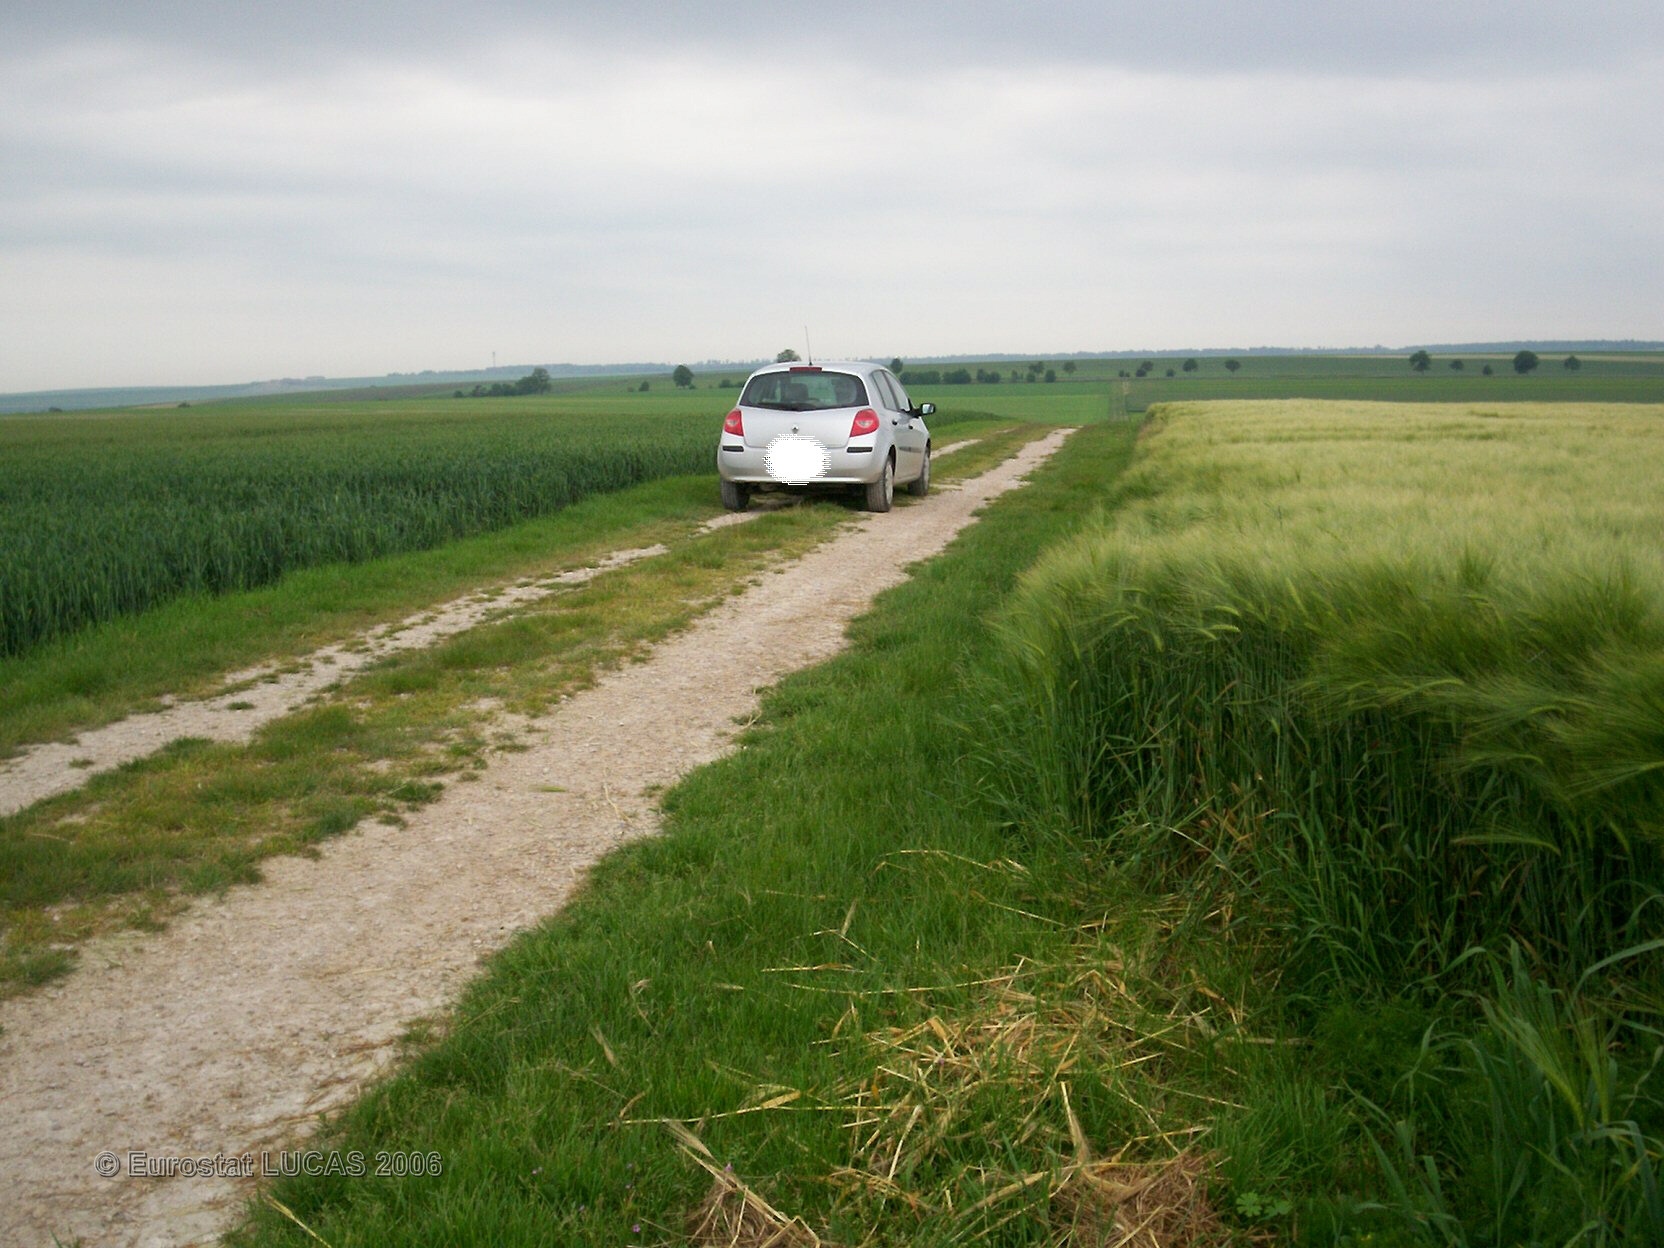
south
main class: Cropland
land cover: Rape and turnip rape
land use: Agriculture (excluding fallow land and kitchen gardens)
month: June
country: FR
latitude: 48.7489
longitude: 4.4069
